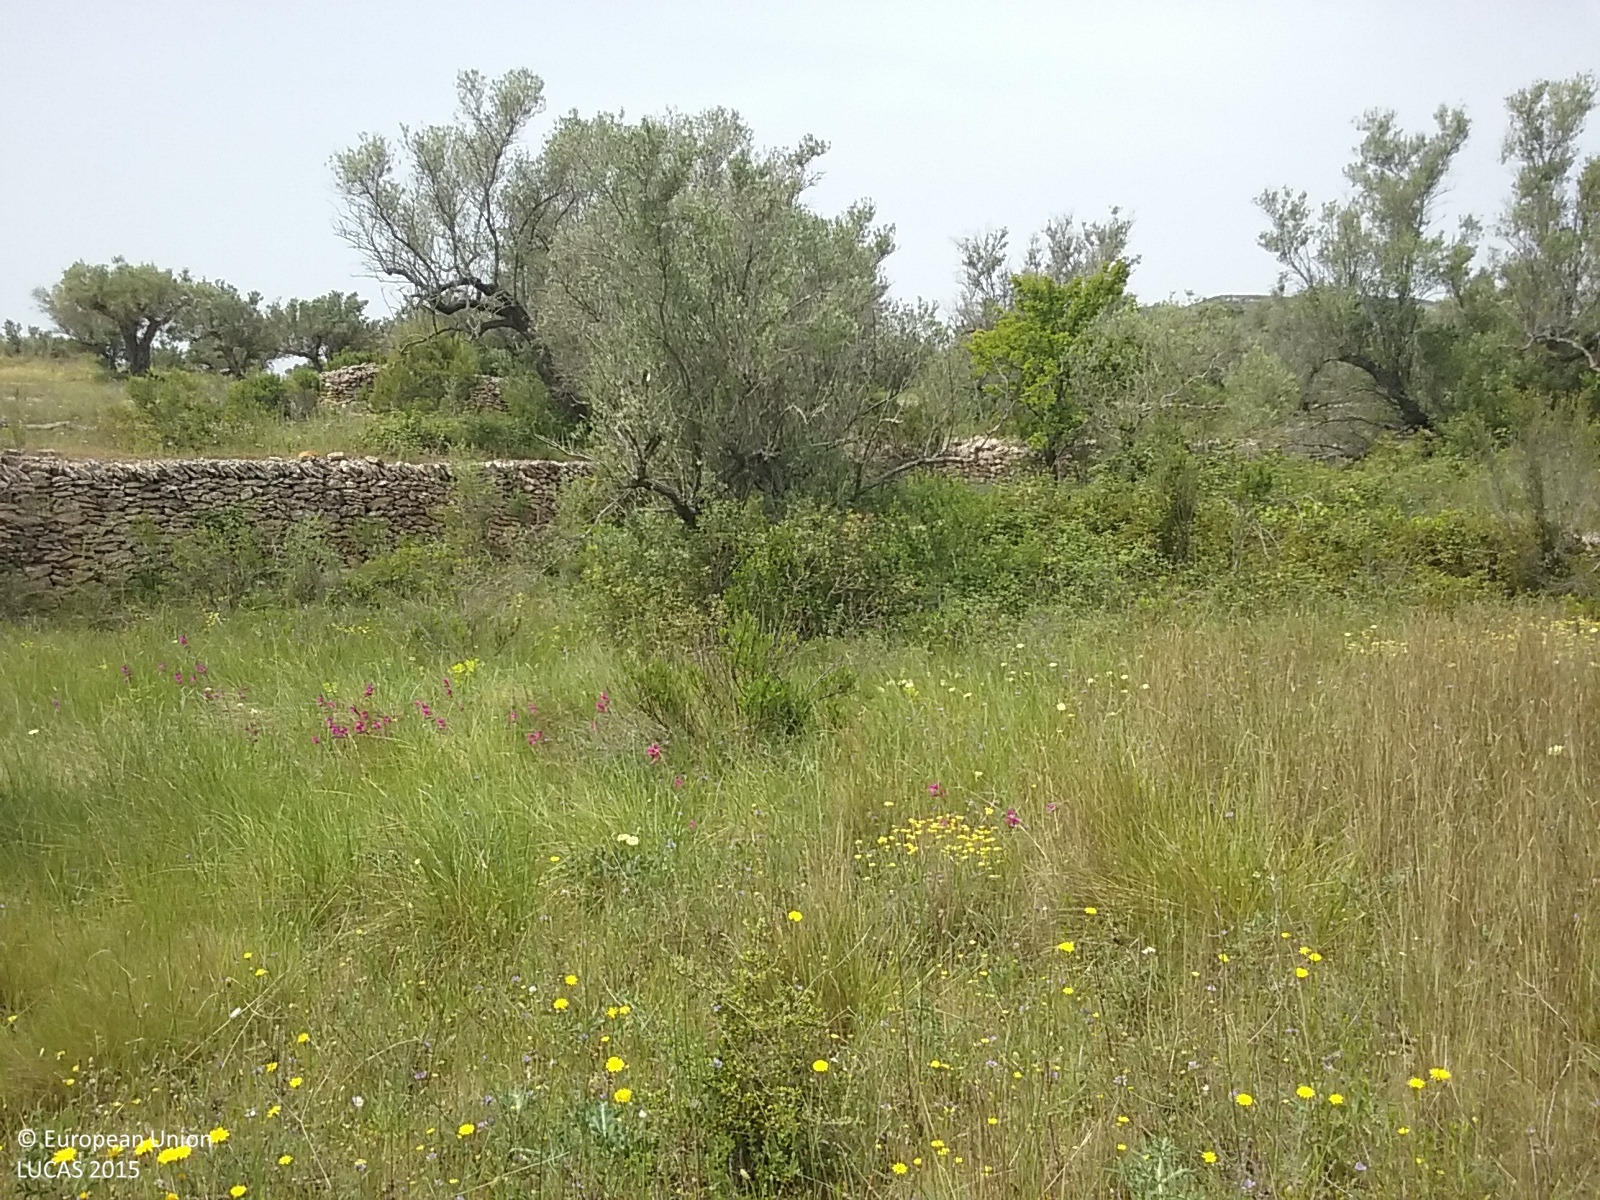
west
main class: Cropland
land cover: Olive groves
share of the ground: 25 - 50 %
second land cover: Grassland without tree/shrub cover
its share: > 75 %
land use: Abandoned areas
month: May
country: ES
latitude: 40.7974
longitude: 0.5954
